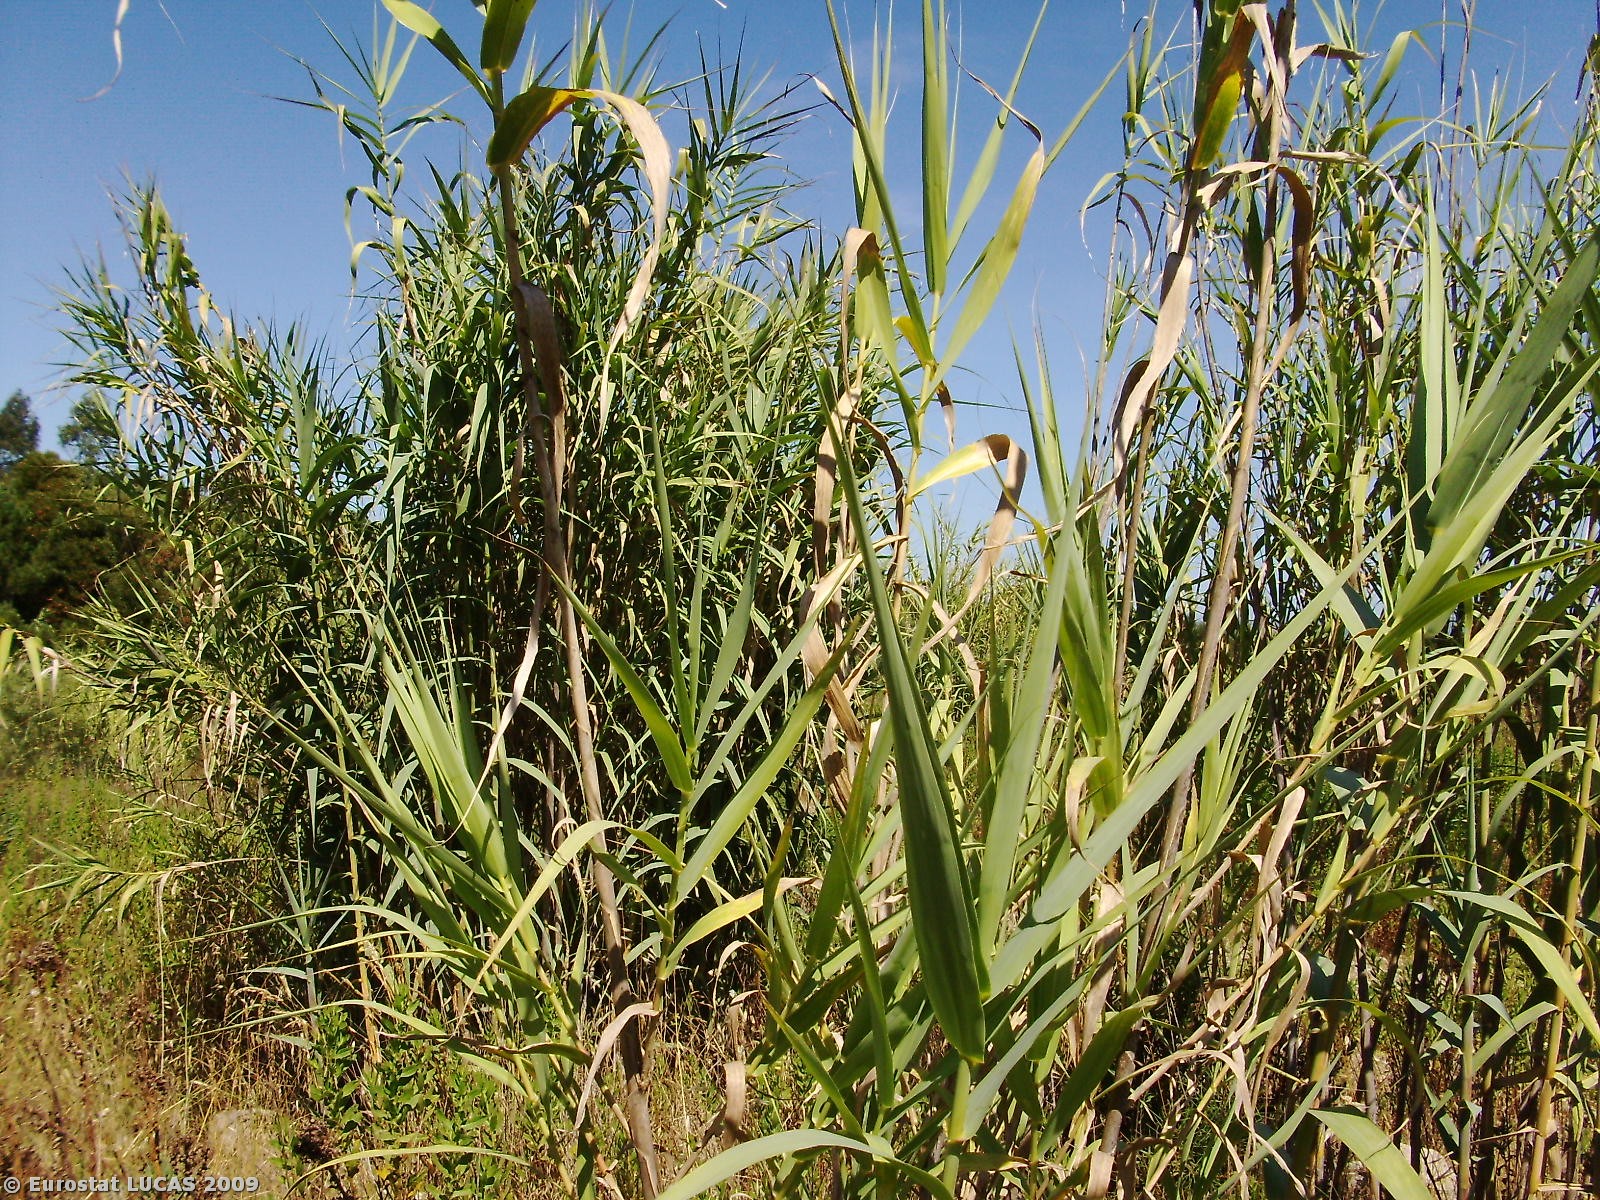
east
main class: Shrubland
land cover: Shrubland with sparse tree cover
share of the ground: > 75 %
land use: Telecommunication
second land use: Fallow land
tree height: > 5 m
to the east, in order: Shrubland with sparse tree cover; Tracks; Shrubland with sparse tree cover; Coniferous woodland; Tracks; Coniferous woodland; Broadleaved woodland; Mixed woodland
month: July
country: PT
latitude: 39.6680
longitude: -8.9136
